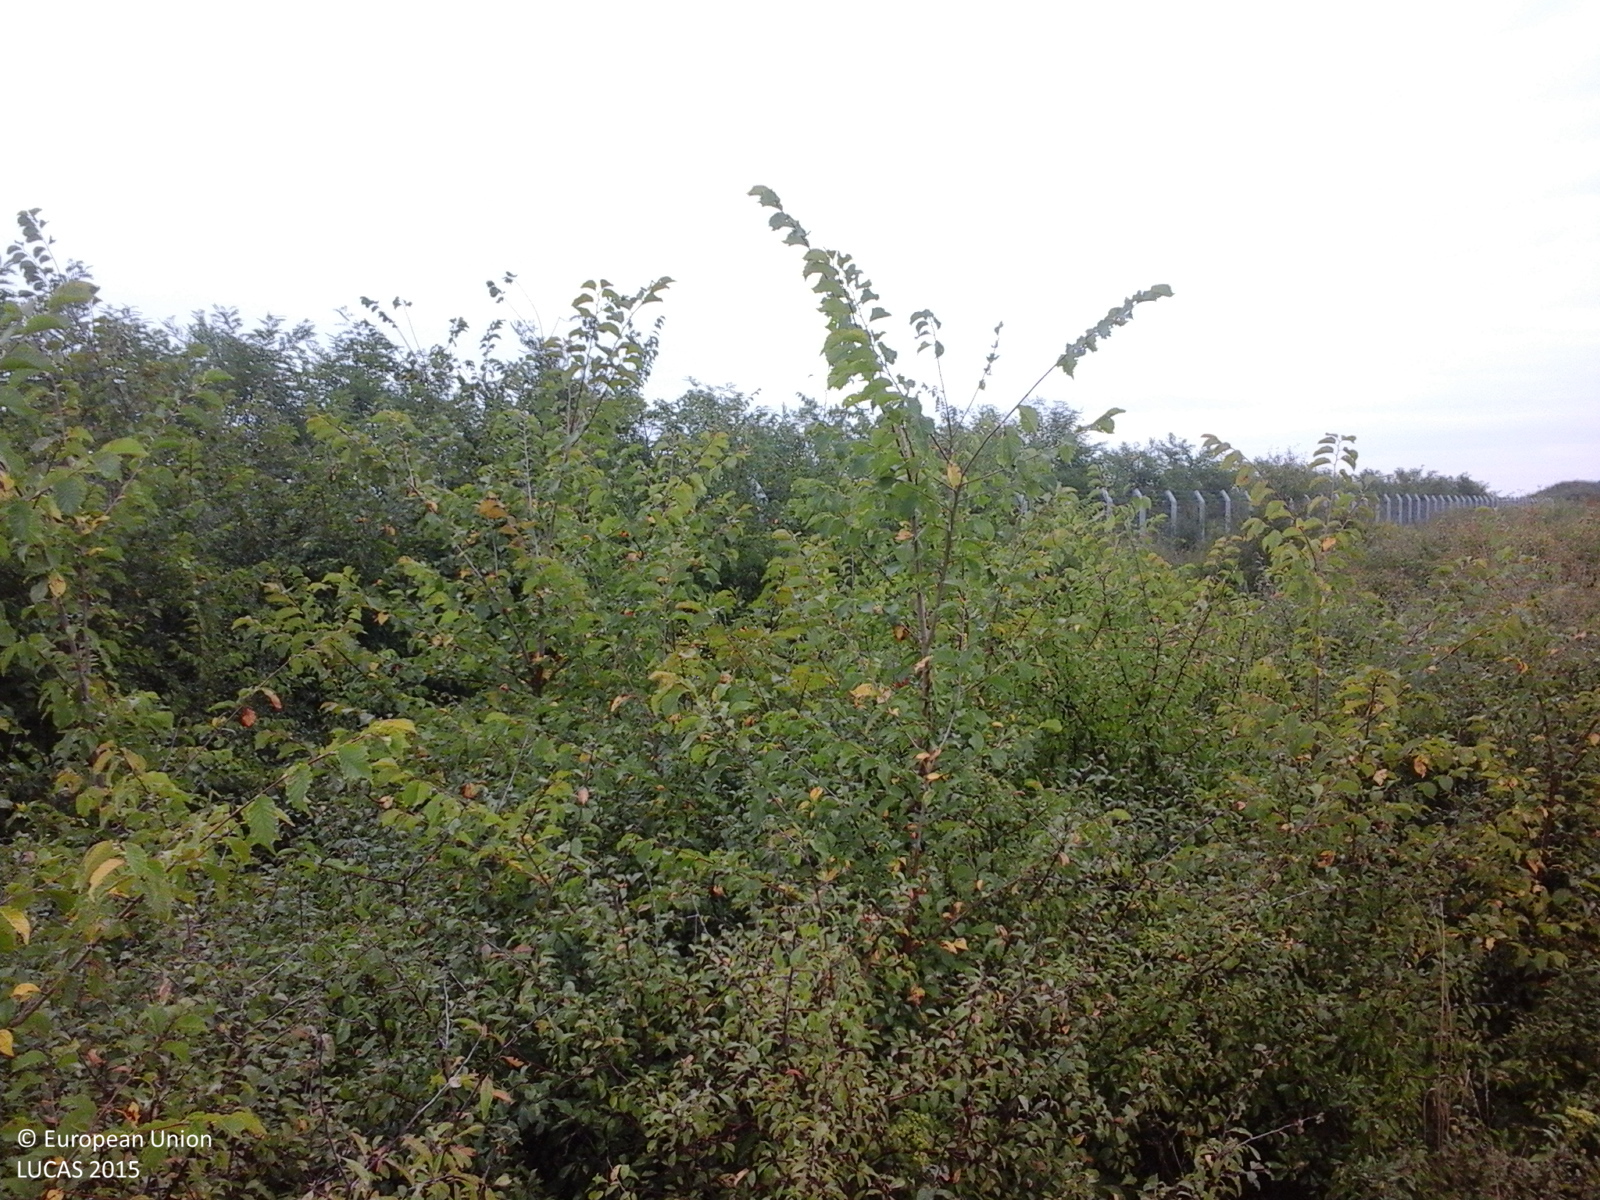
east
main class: Shrubland
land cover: Shrubland with sparse tree cover
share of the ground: > 75 %
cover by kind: shrubs 90 %, broadleaved forest trees 5 %, herbaceous plants 5 %
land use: Semi-natural and natural areas not in use
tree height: < 5 m
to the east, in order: Shrubland with sparse tree cover; Fences; Lines of trees; Grassland without tree/shrub cover; Tracks; Other bare soil; Tracks; Grassland without tree/shrub cover
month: August
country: RO
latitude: 45.7914
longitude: 21.7564
